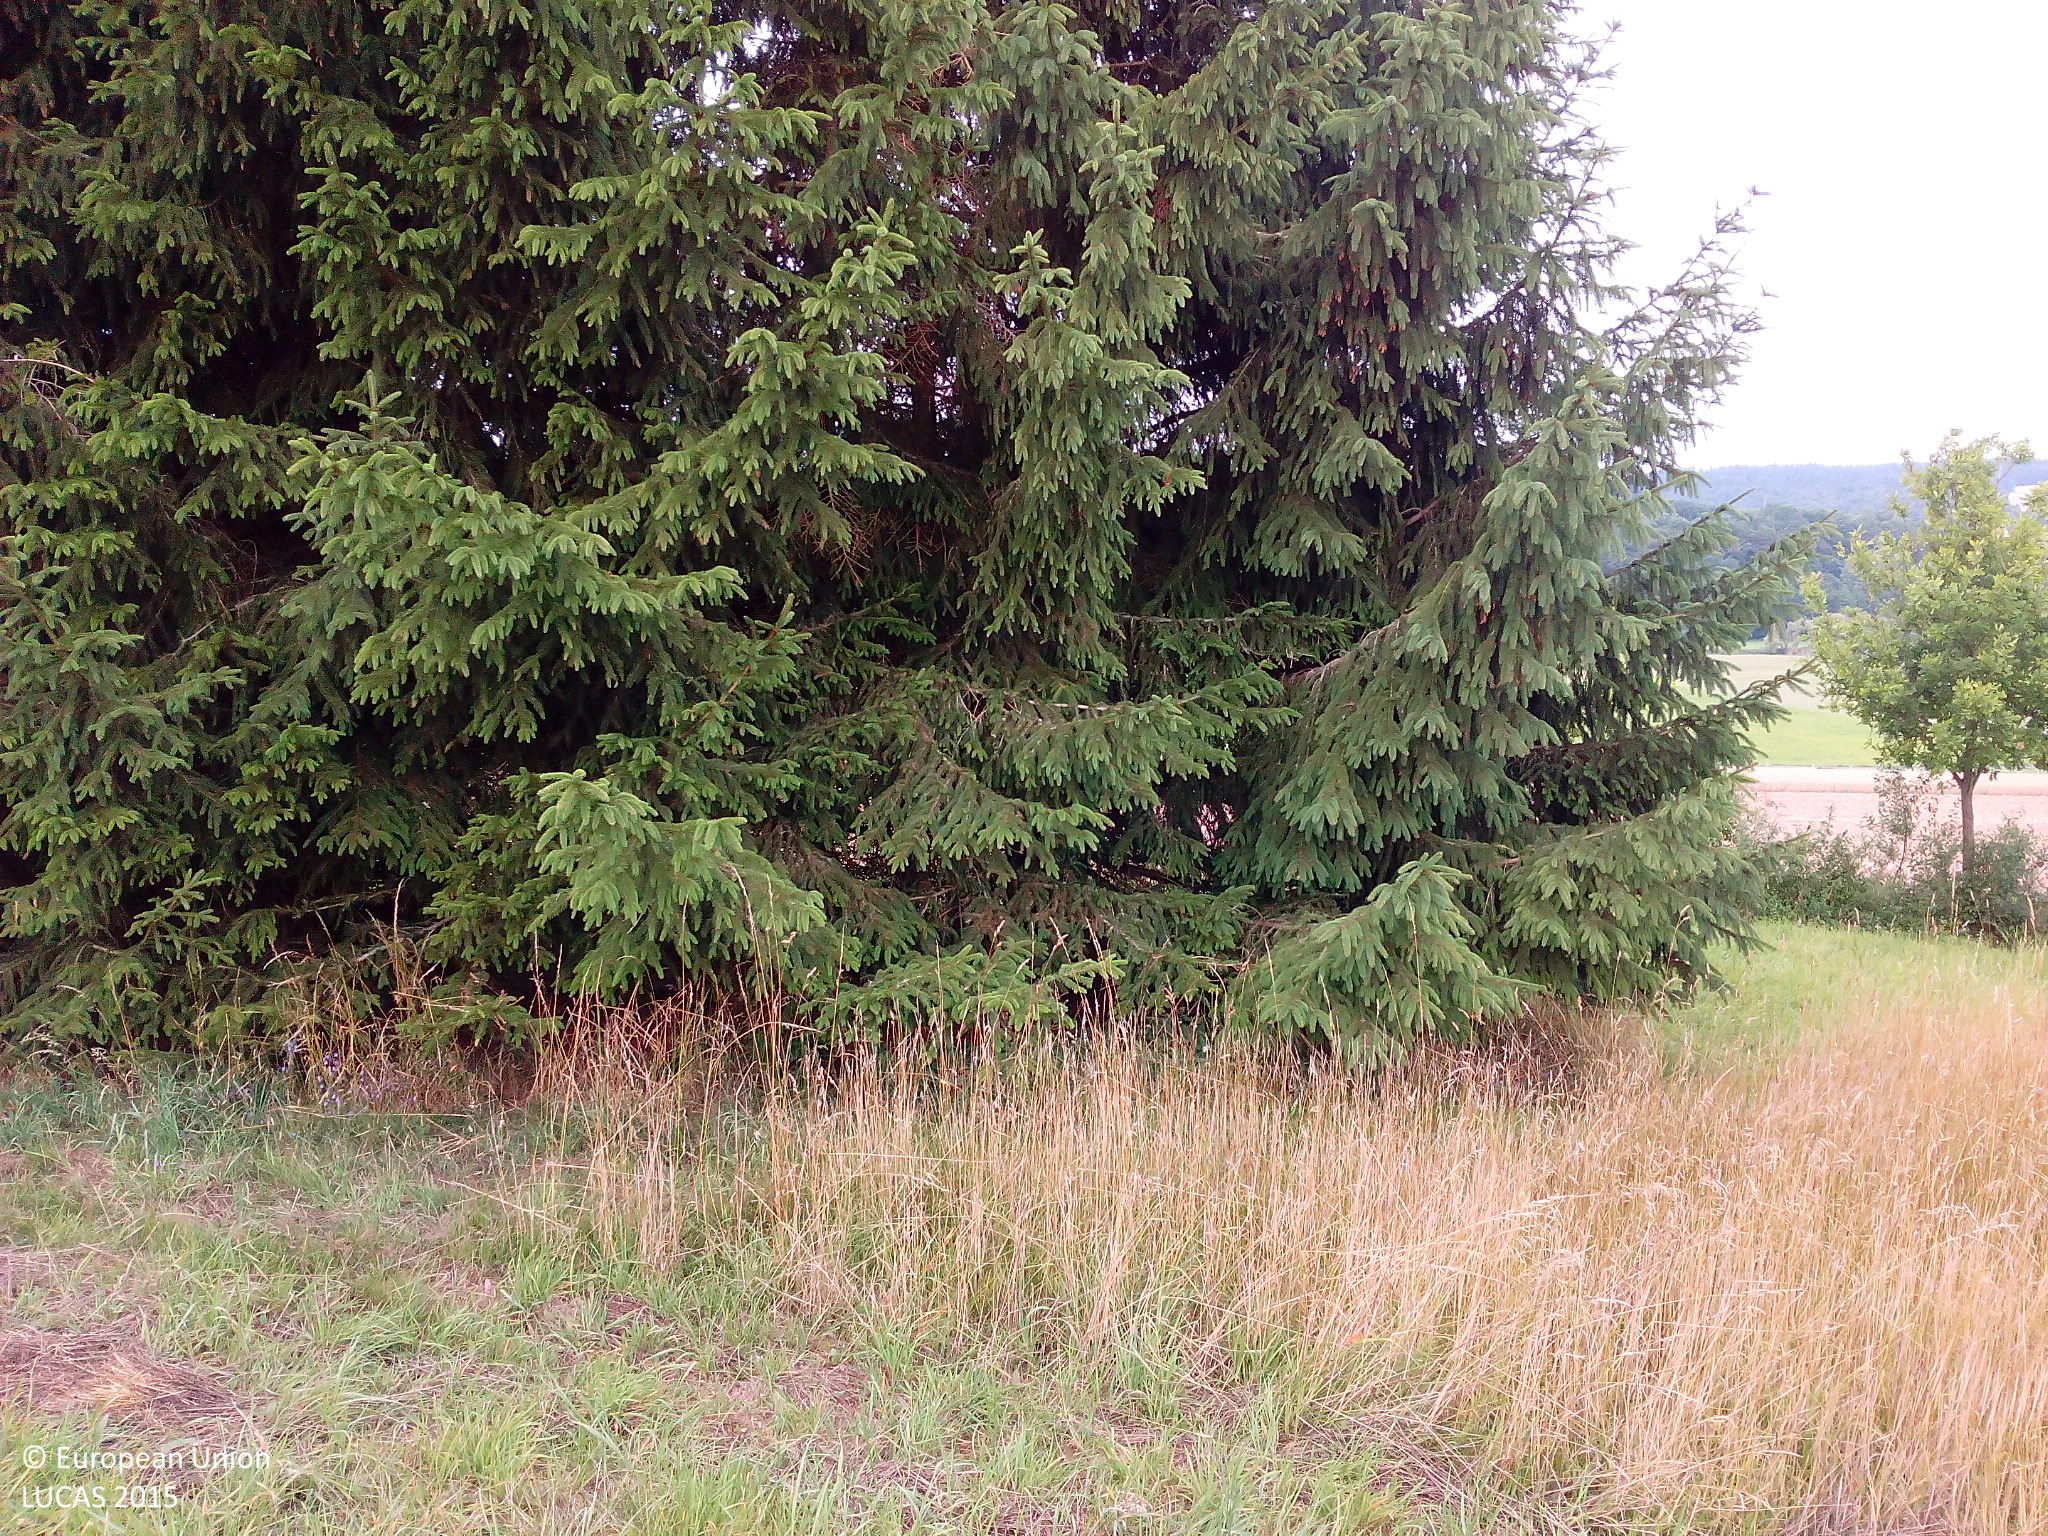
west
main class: Cropland
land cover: Common wheat
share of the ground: > 75 %
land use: Agriculture (excluding fallow land and kitchen gardens)
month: August
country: DE
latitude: 50.7409
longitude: 9.5892
